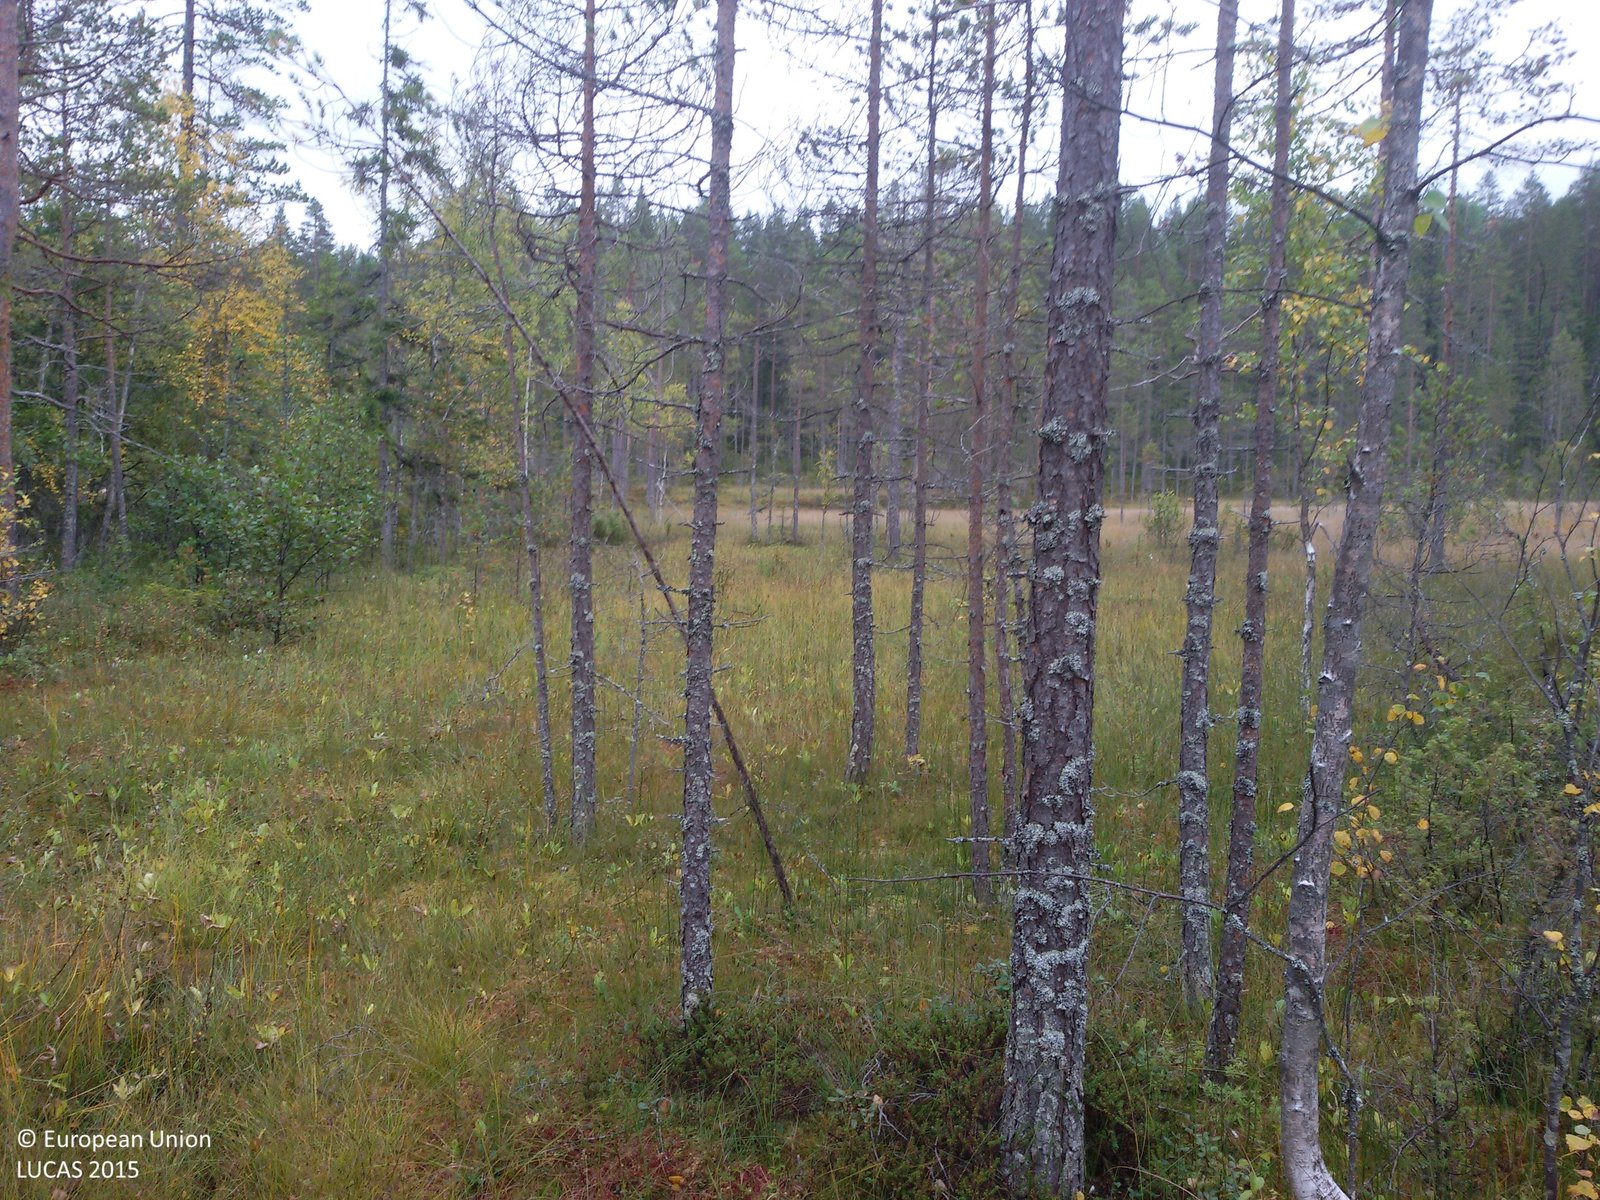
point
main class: Woodland
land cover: Pine dominated coniferous woodland
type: boreal forest
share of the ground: 50 - 75 %
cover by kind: coniferous forest trees 50 %, shrubs 25 %, lichens and mosses 25 %
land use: Forestry
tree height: > 5 m
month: September
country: SE
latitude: 61.0349
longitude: 14.3000
